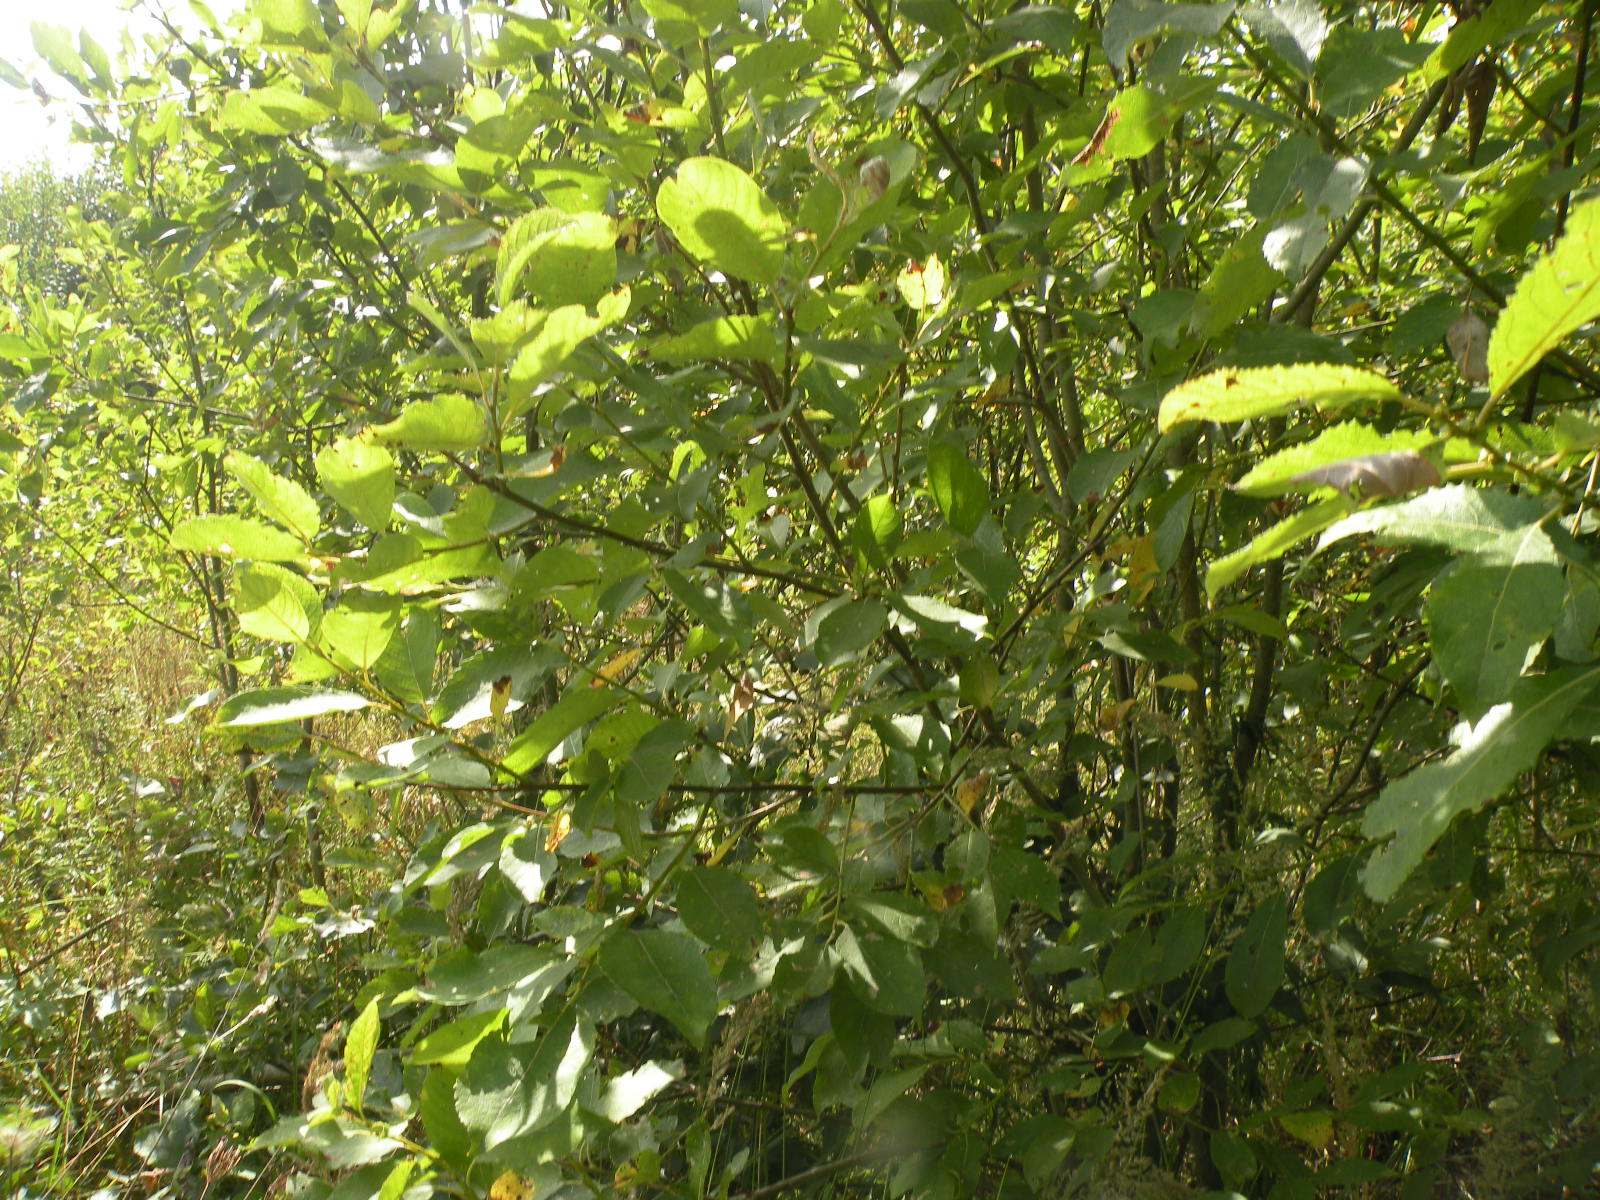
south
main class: Woodland
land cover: Broadleaved woodland
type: non-riverine alder, birch or aspen forest
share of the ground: > 75 %
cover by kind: broadleaved forest trees 75 %, herbaceous plants 15 %, shrubs 10 %
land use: Forestry
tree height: > 5 m
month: August
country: LV
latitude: 55.8689
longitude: 26.1697
